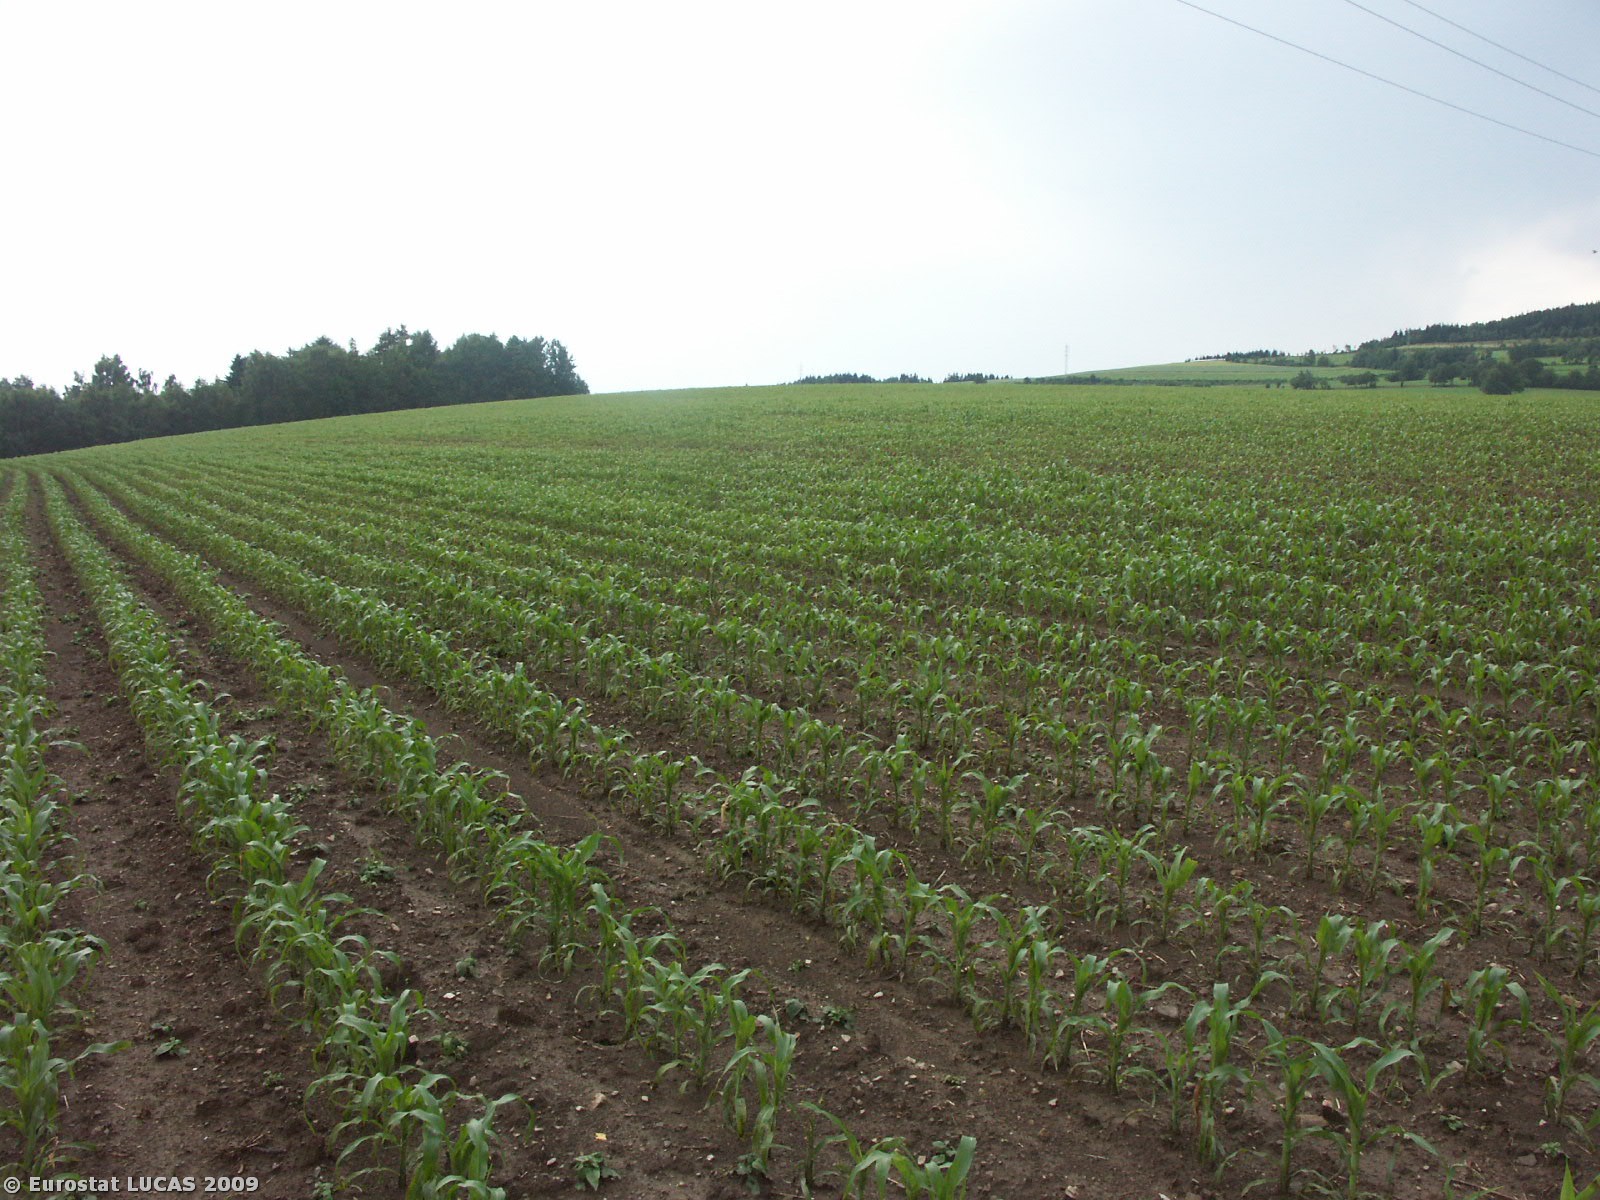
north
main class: Cropland
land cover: Maize
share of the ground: 10 - 25 %
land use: Agriculture (excluding fallow land and kitchen gardens)
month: July
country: CZ
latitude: 49.9894
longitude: 16.6614
